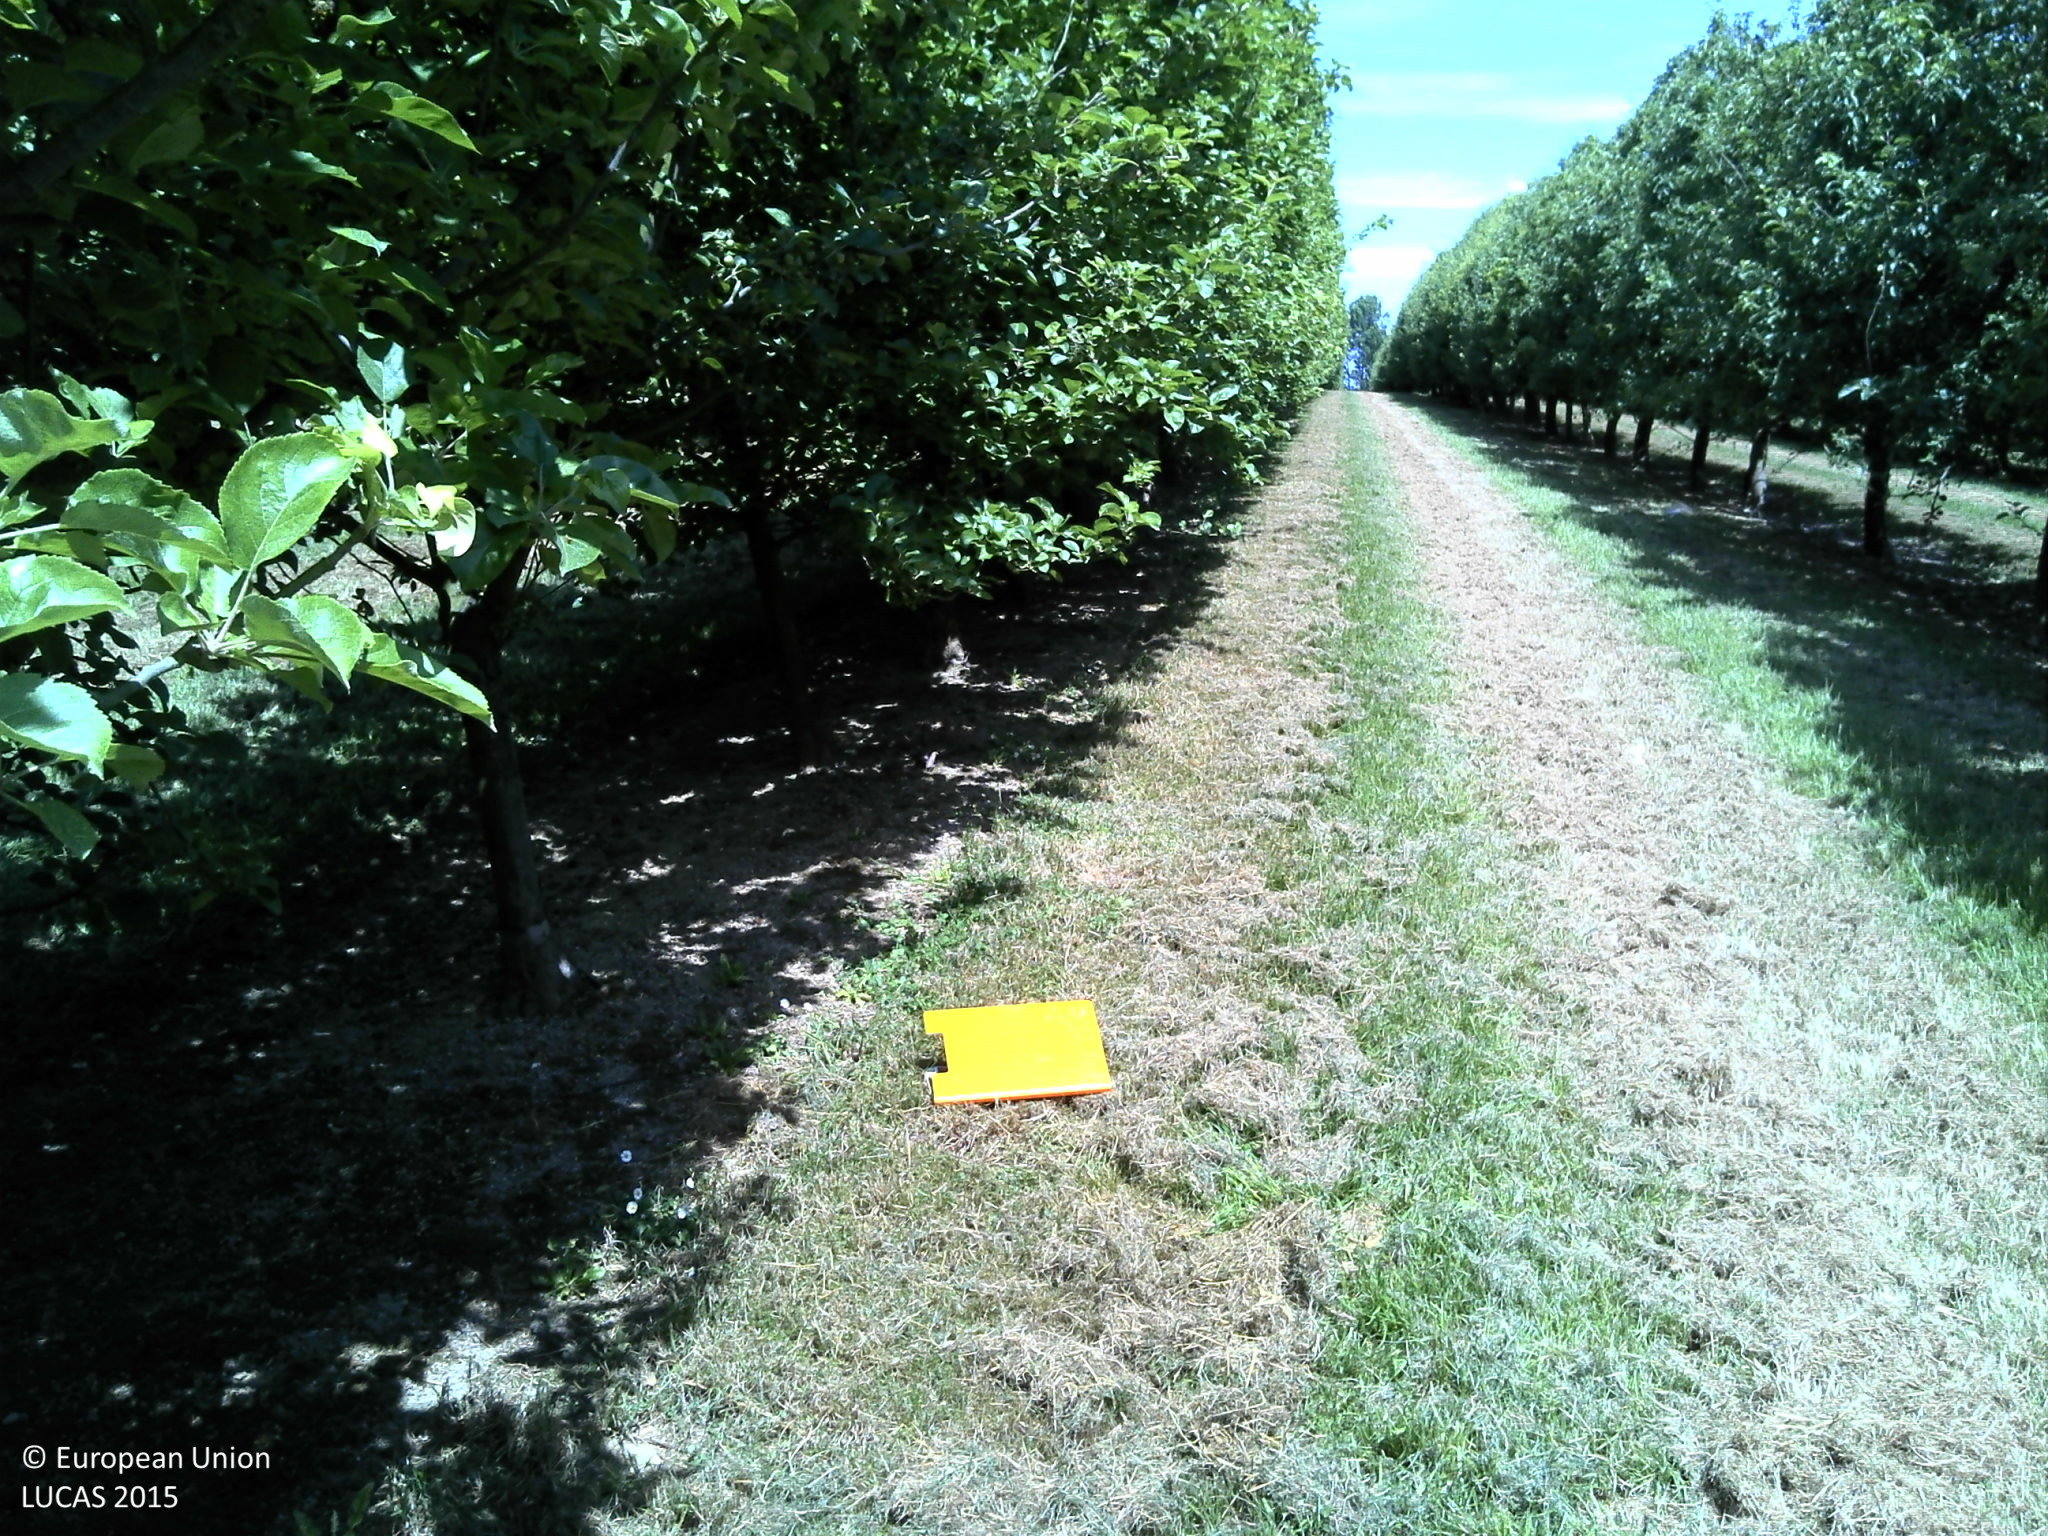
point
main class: Cropland
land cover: Apple fruit
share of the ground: 50 - 75 %
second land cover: Grassland without tree/shrub cover
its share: 50 - 75 %
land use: Agriculture (excluding fallow land and kitchen gardens)
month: June
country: FR
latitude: 49.7816
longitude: 1.1037
